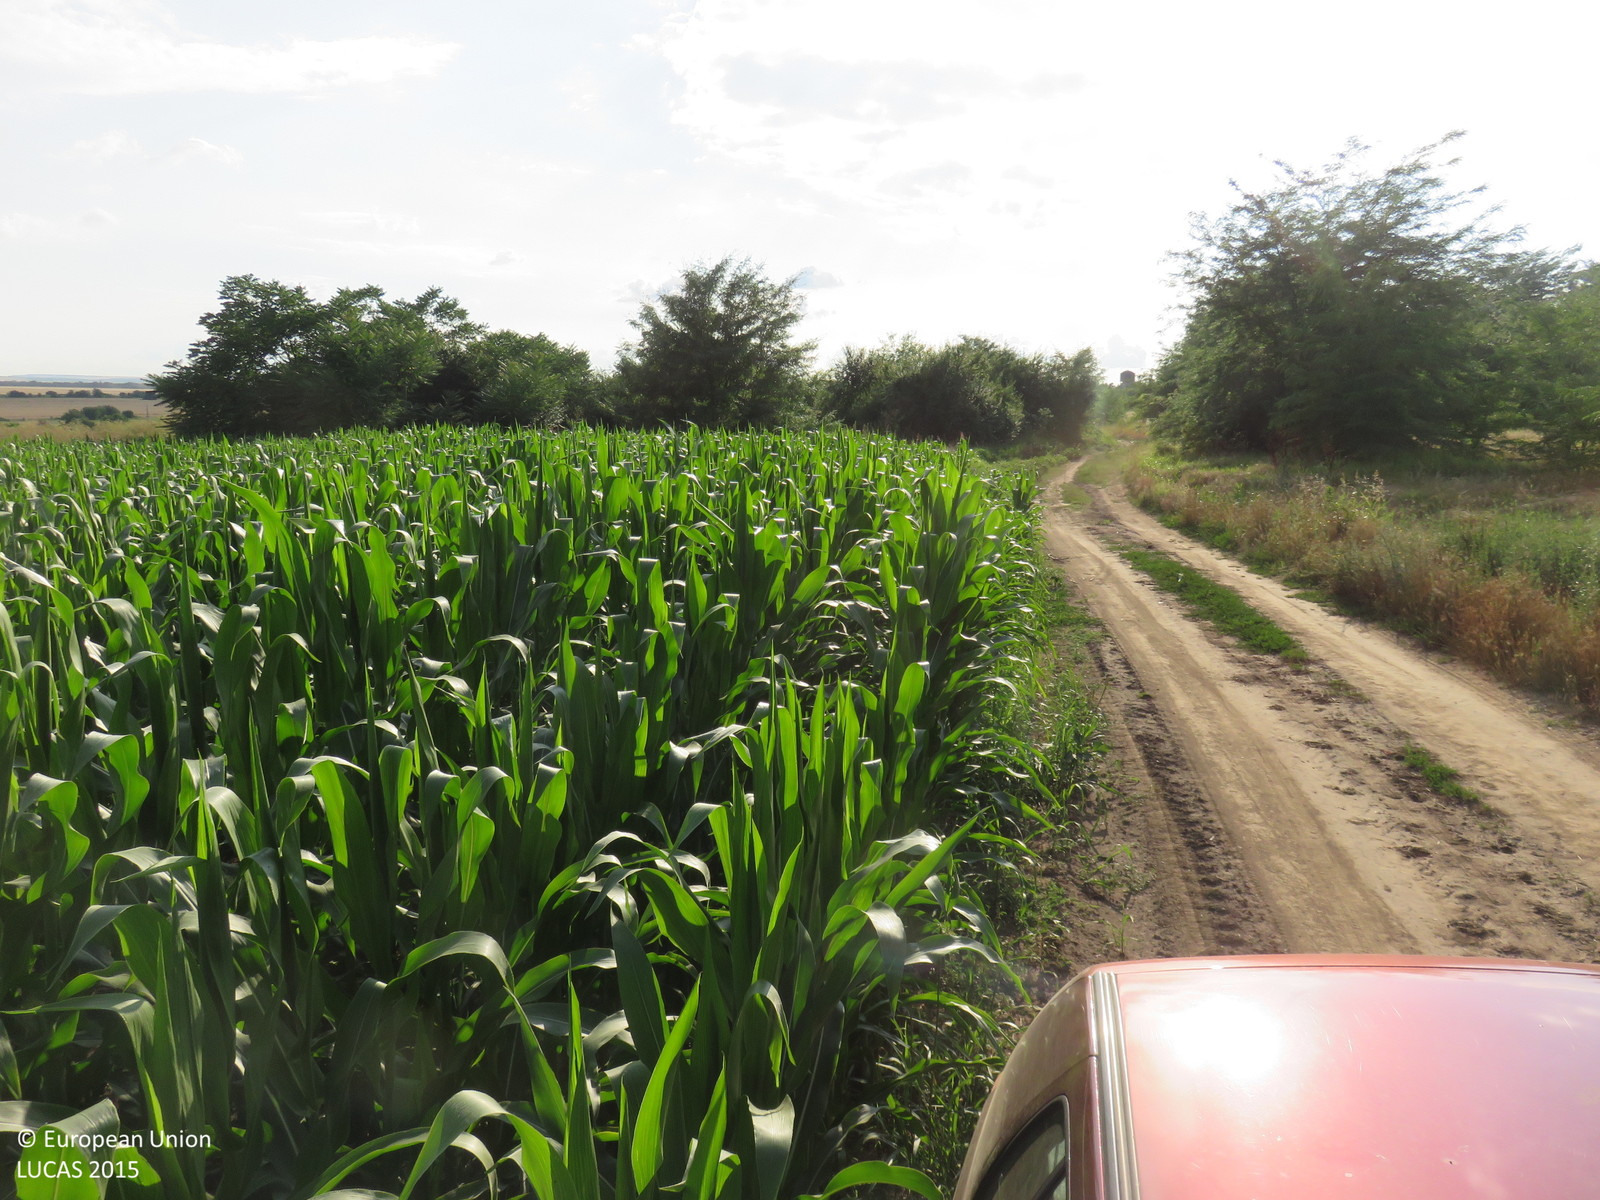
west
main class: Cropland
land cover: Maize
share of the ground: > 75 %
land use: Agriculture (excluding fallow land and kitchen gardens)
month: June
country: BG
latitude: 43.3717
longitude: 24.9400
